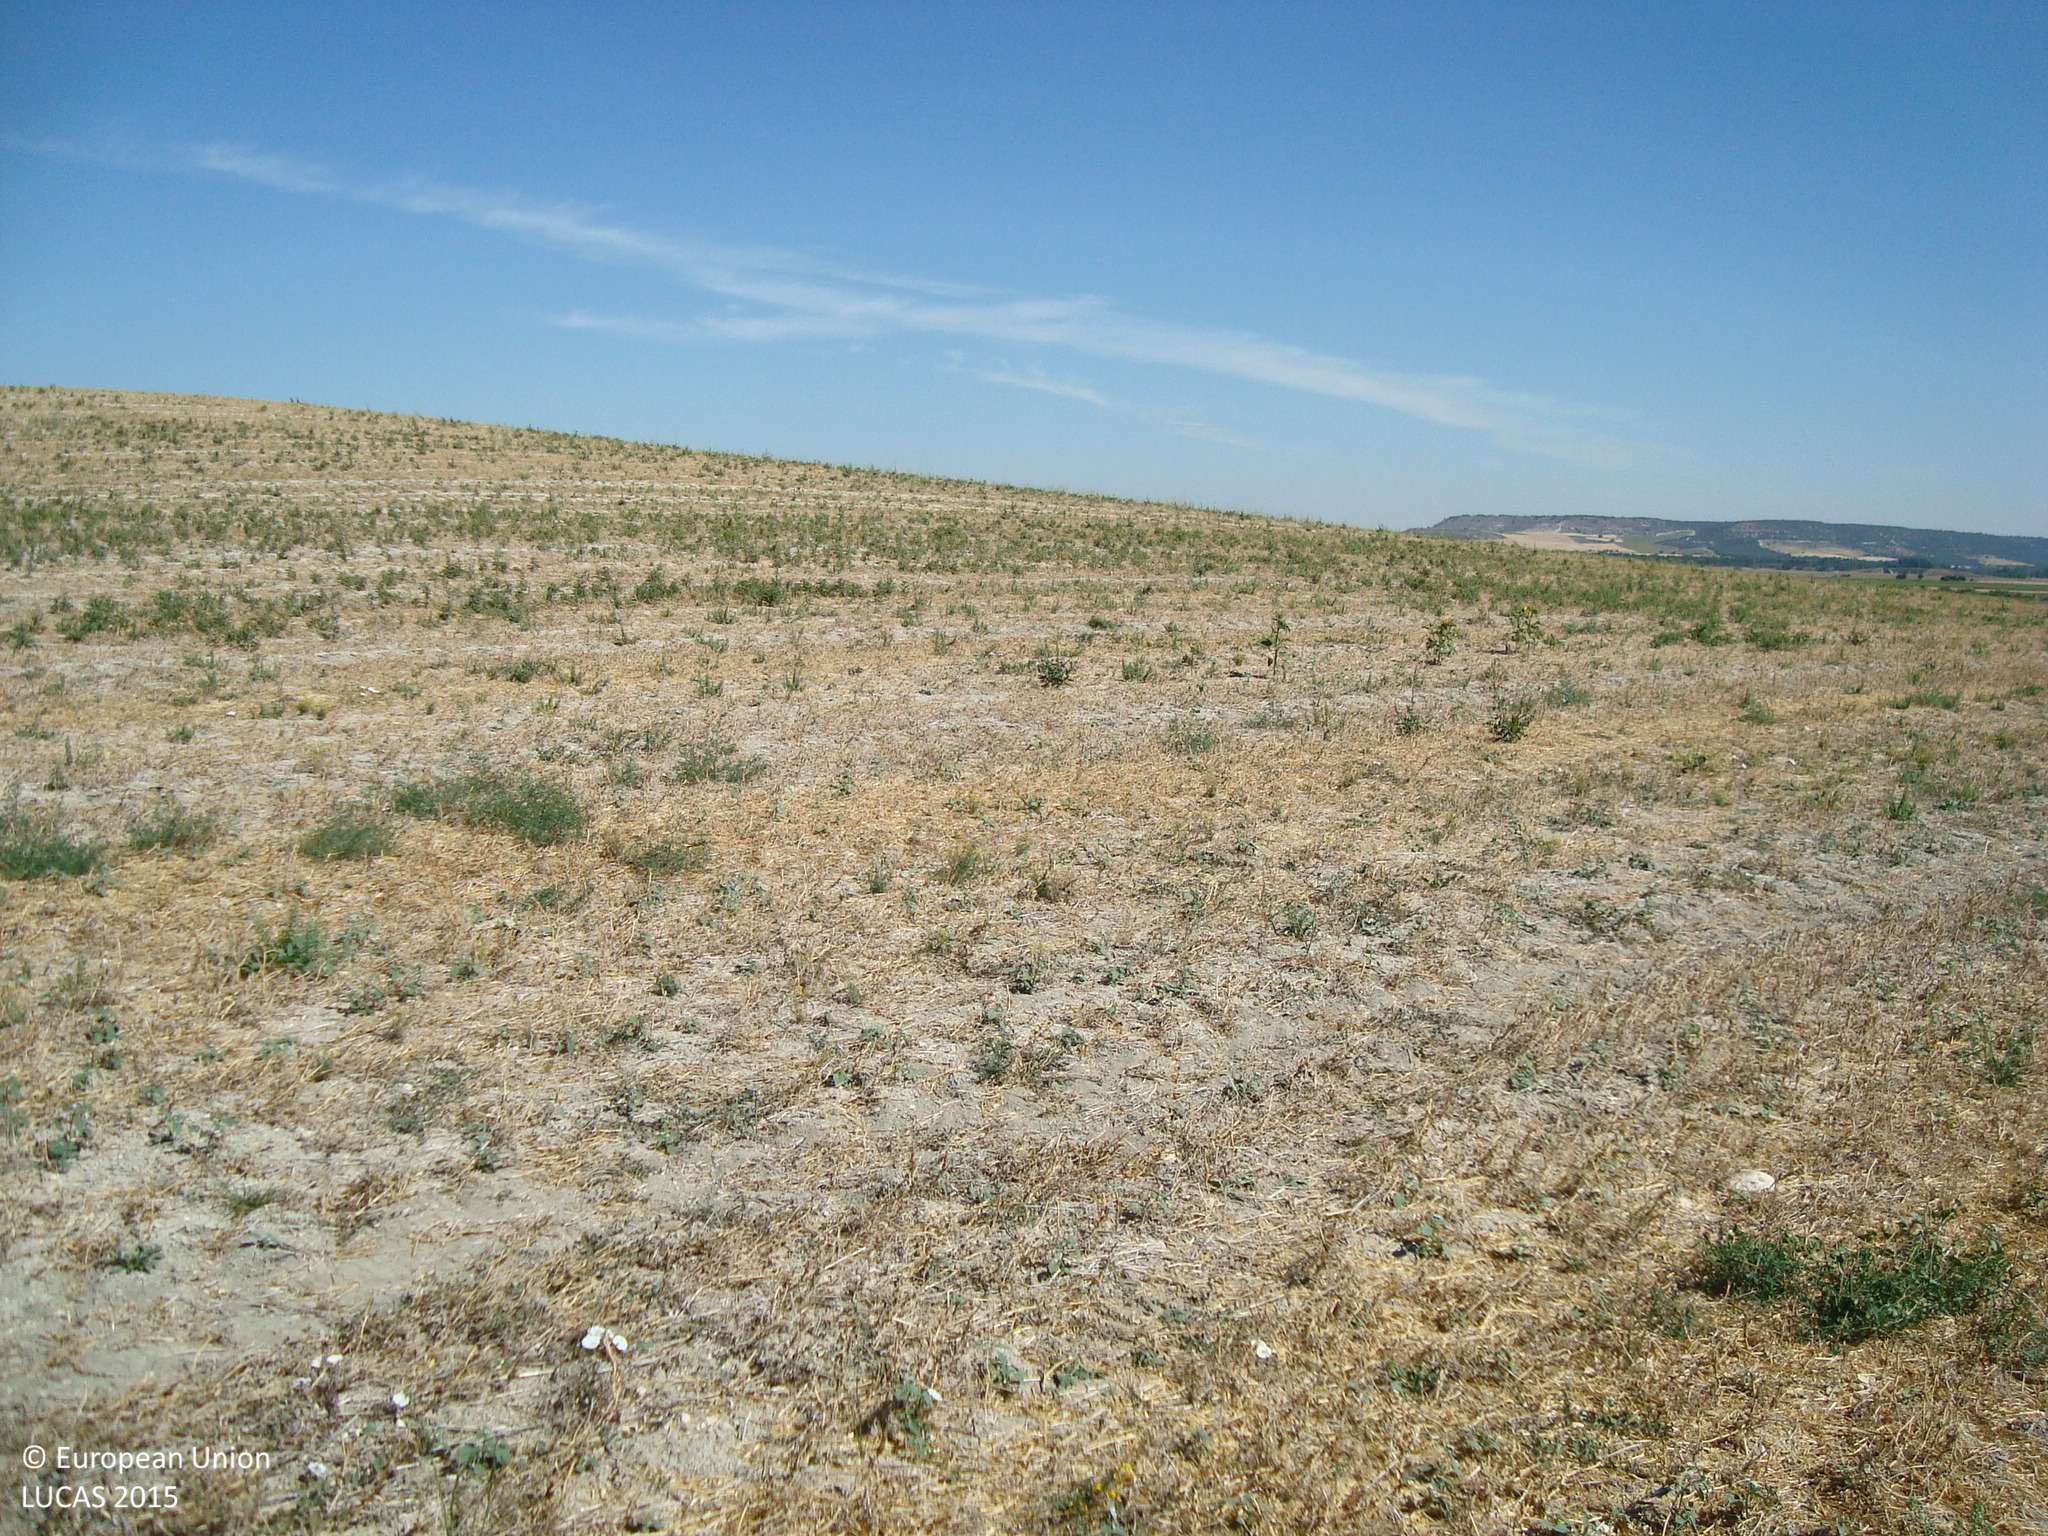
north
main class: Cropland
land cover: Dry pulses
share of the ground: 50 - 75 %
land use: Agriculture (excluding fallow land and kitchen gardens)
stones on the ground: 10 - 25 %
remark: Harvested field
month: July
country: ES
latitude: 42.0242
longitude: -4.2566
